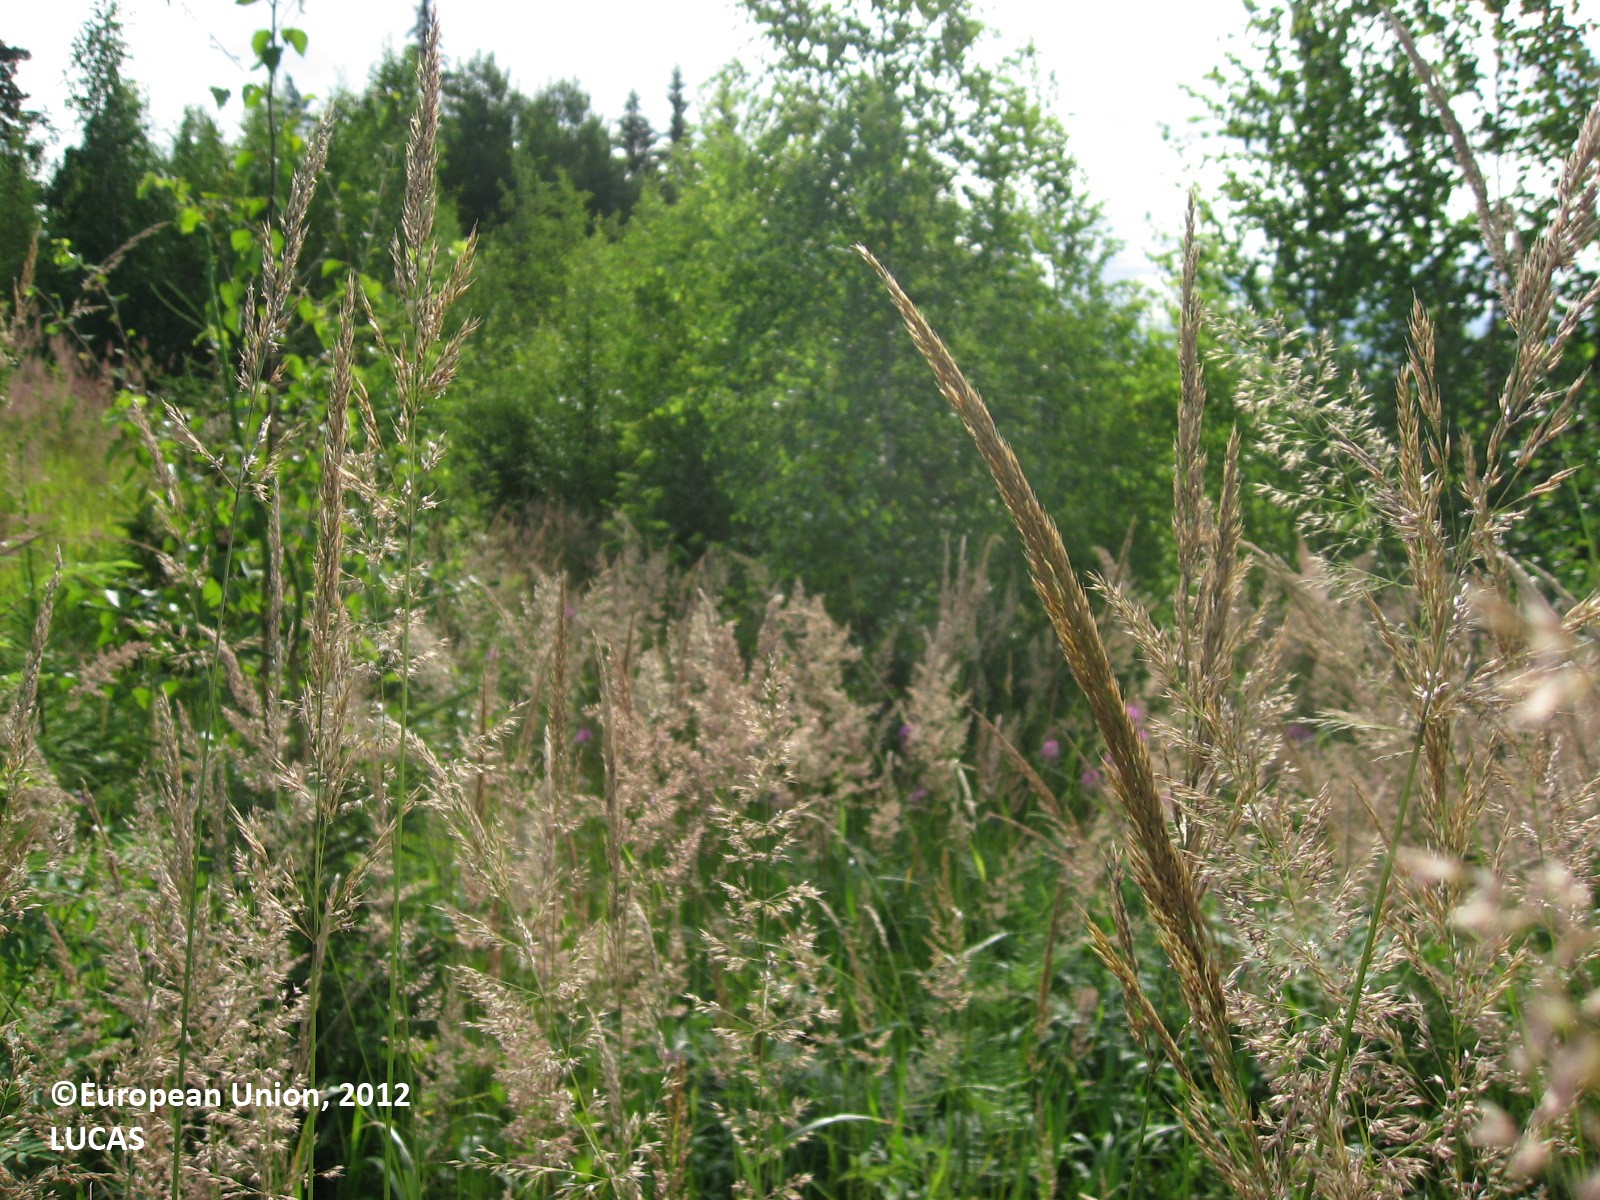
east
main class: Woodland
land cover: Broadleaved woodland
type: boreal forest
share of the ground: 10 - 25 %
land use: Forestry
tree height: < 5 m
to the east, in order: Broadleaved woodland; Other mixed woodland; Ditches and canals; Paved roads, cycling and walking lanes; Broadleaved woodland; Spruce dominated coniferous woodland; Broadleaved woodland; Spruce dominated coniferous woodland
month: July
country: FI
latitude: 61.2002
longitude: 25.7801
